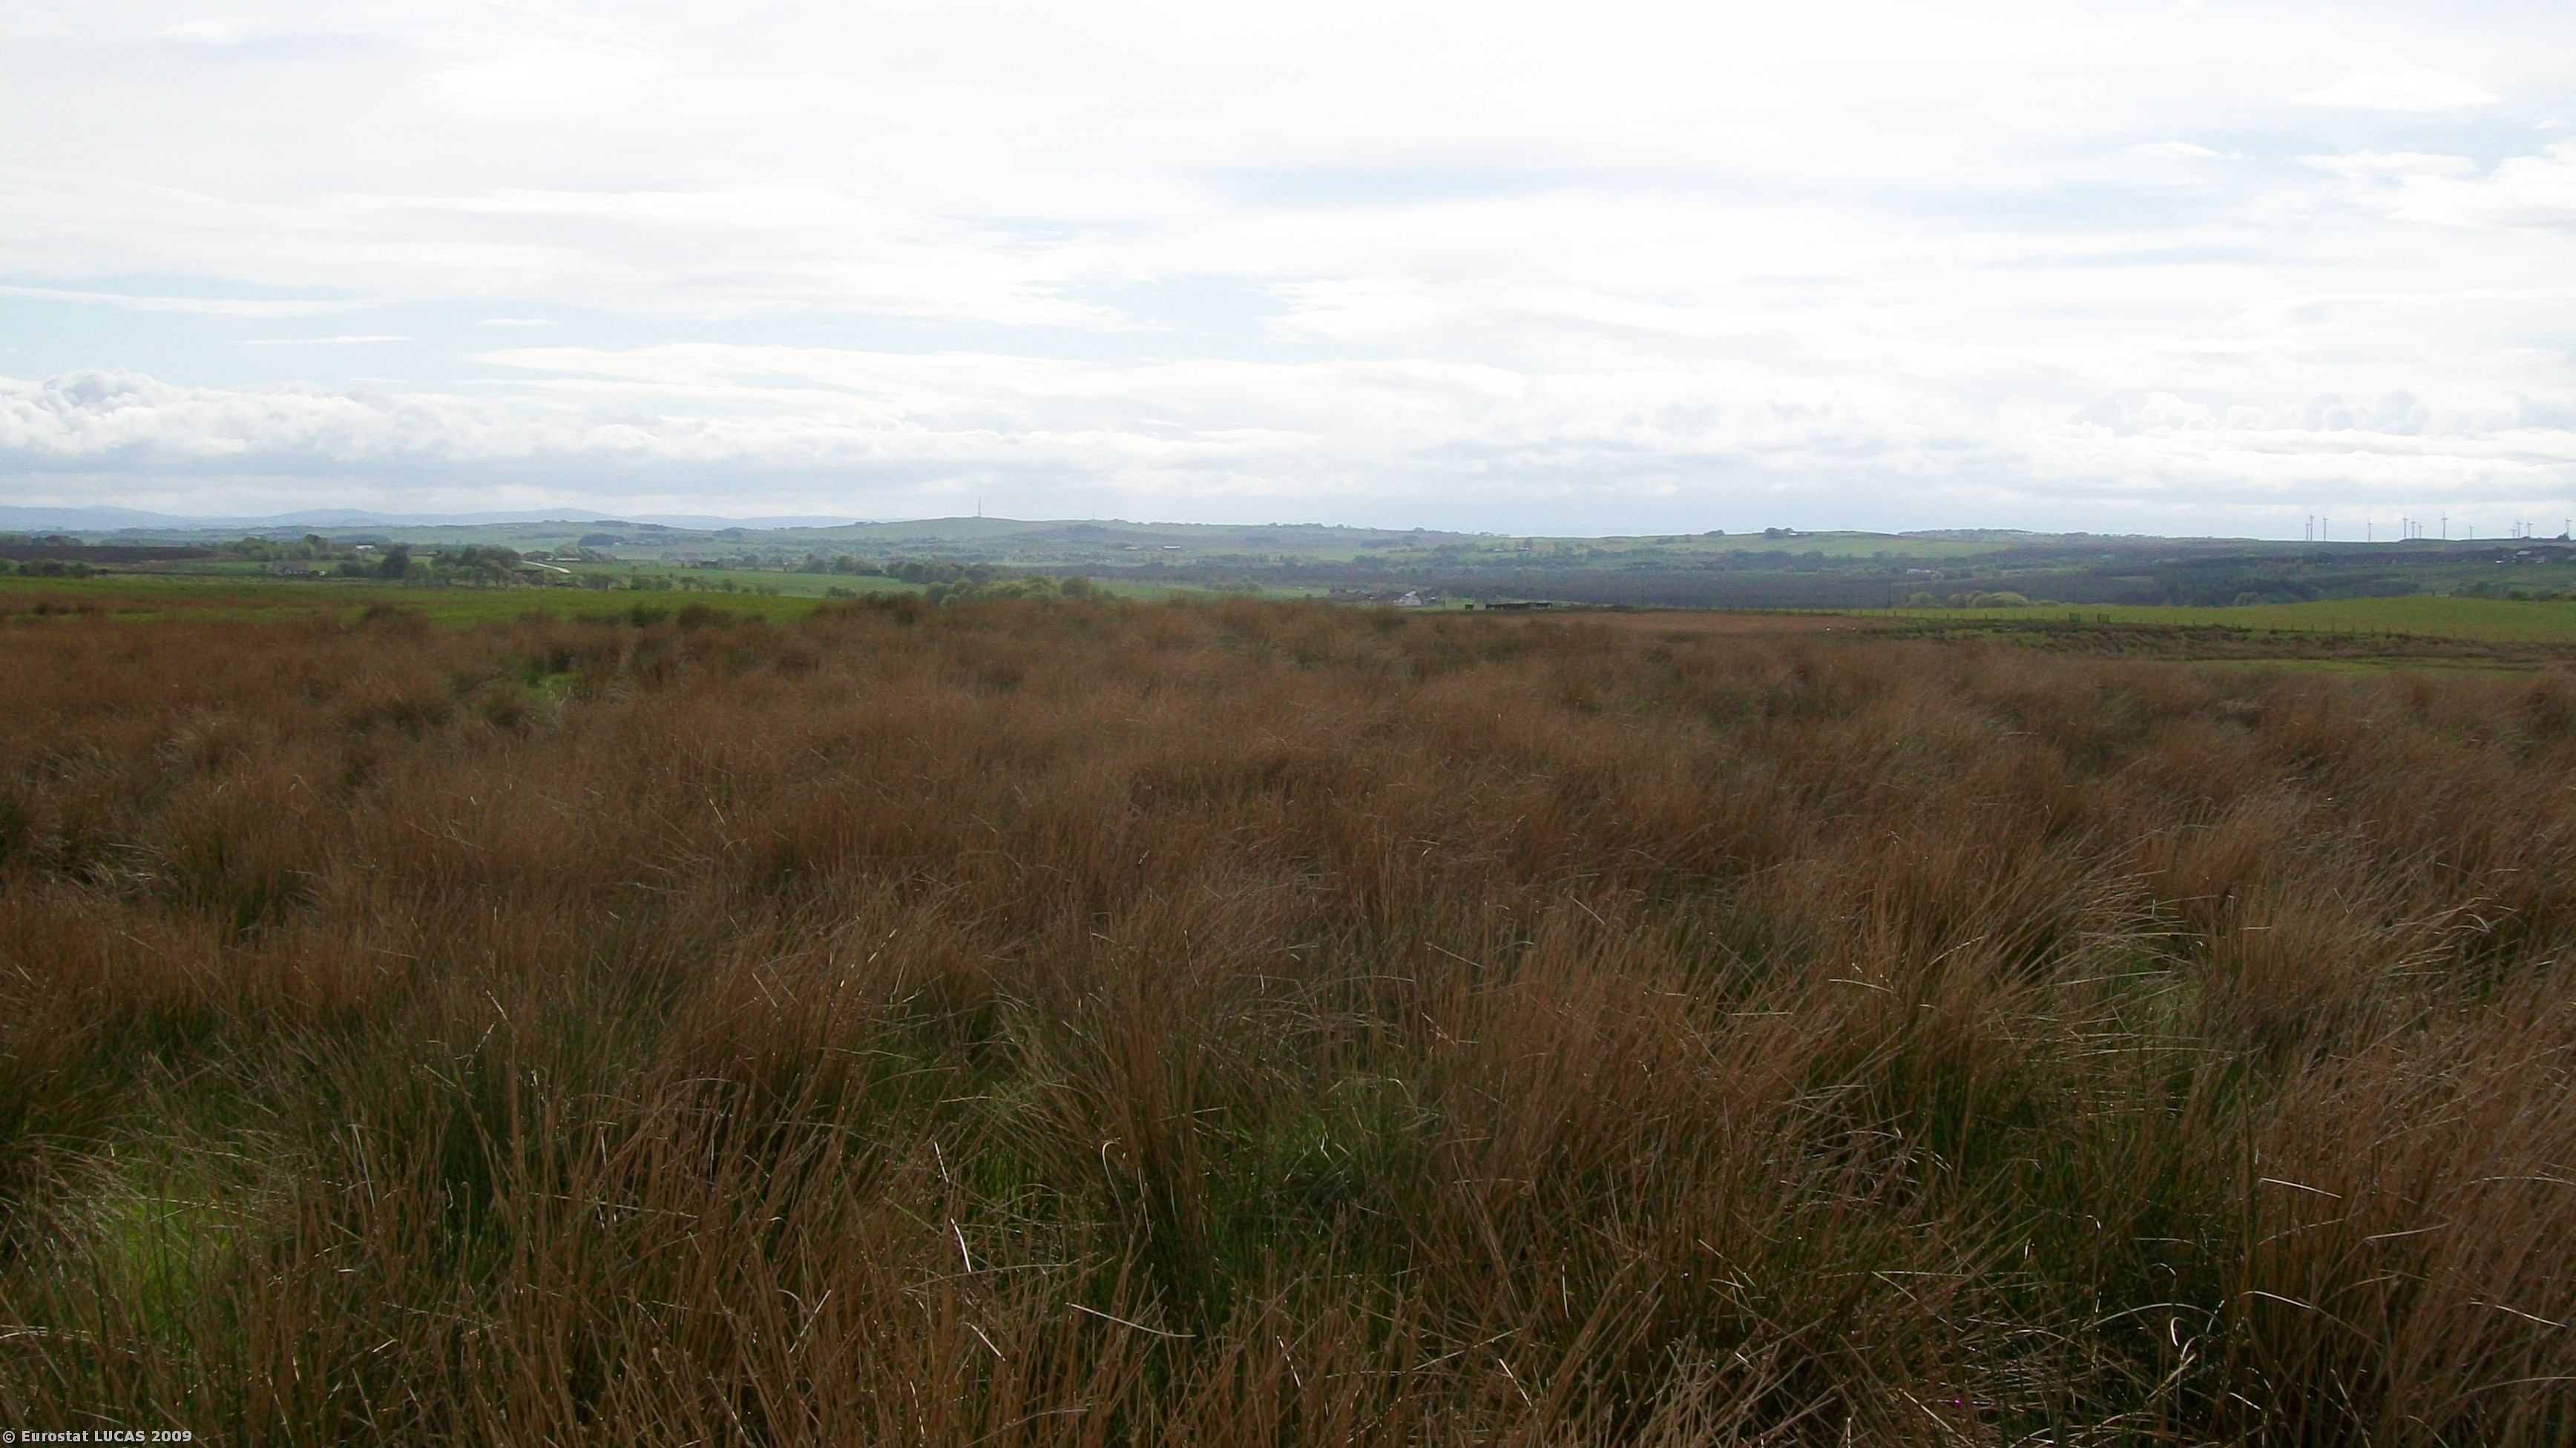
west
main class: Grassland
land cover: Grassland without tree/shrub cover
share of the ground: > 75 %
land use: Agriculture (excluding fallow land and kitchen gardens)
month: May
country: GB
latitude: 55.7648
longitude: -3.6441
